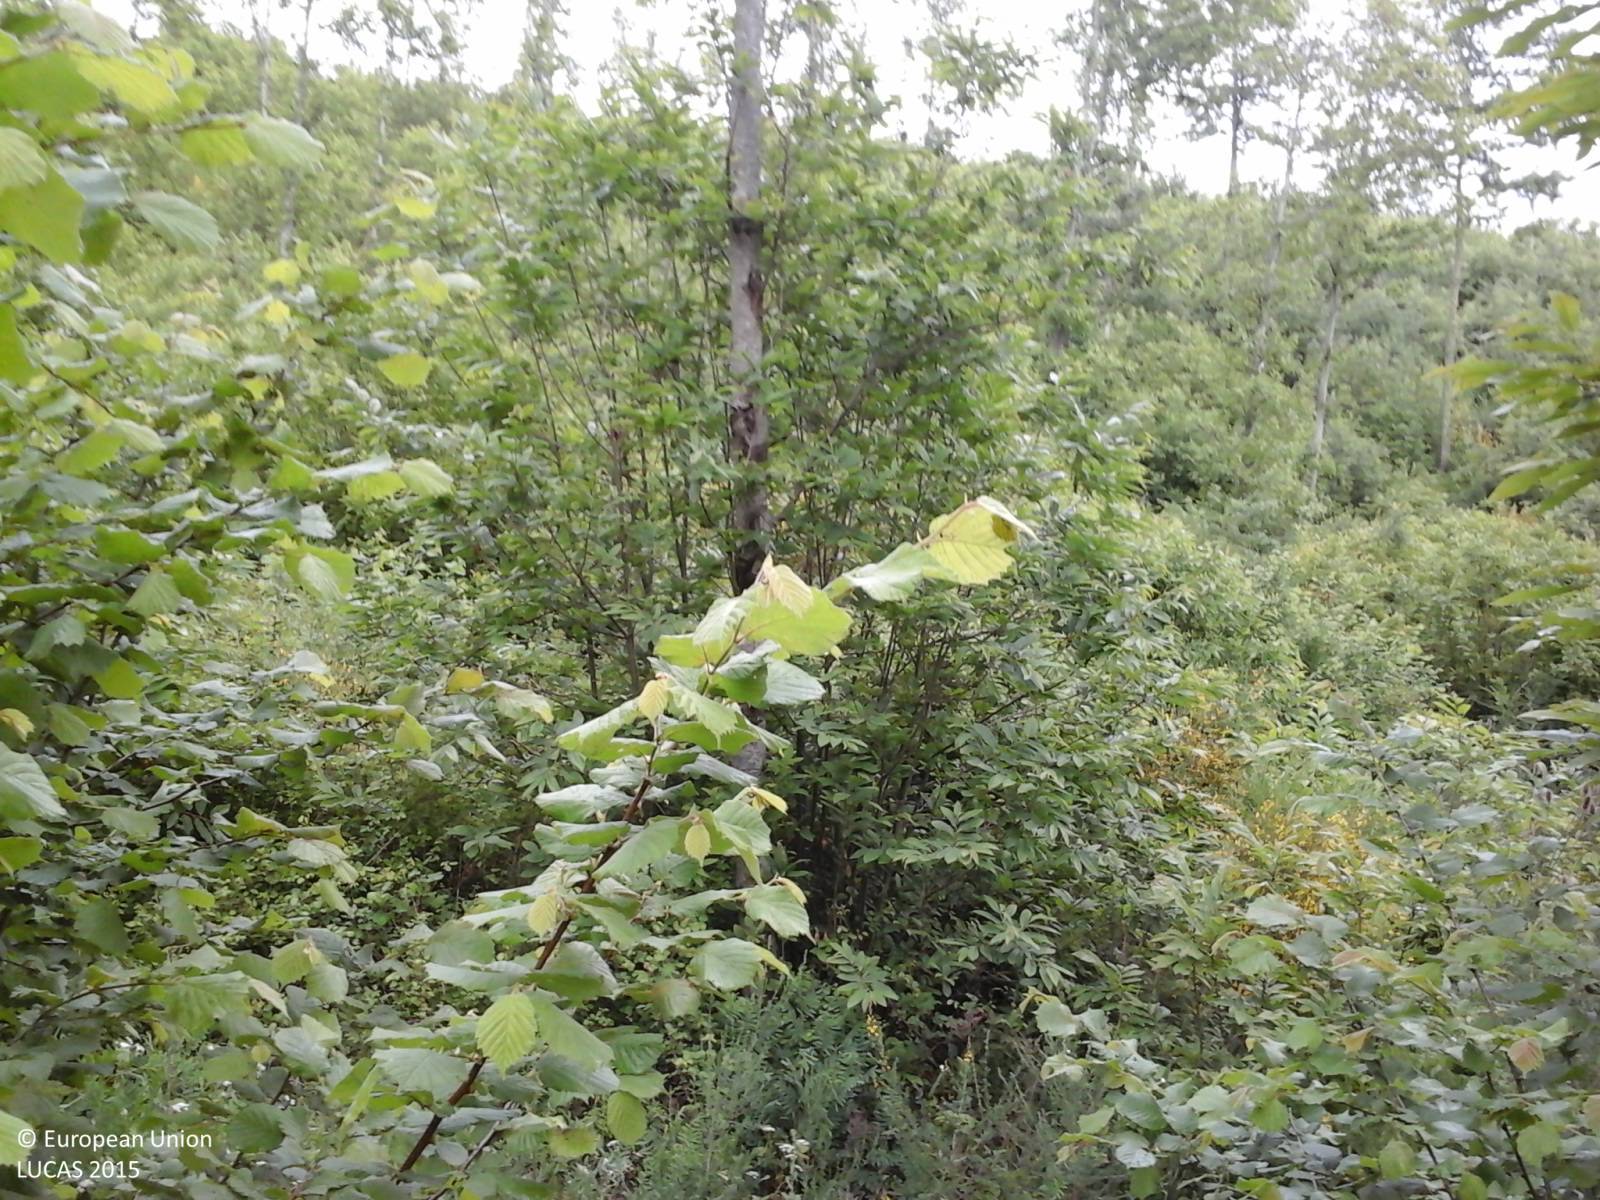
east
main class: Woodland
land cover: Broadleaved woodland
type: thermophilous deciduous forest
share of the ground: > 75 %
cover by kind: broadleaved forest trees 100 %
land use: Forestry
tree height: > 5 m
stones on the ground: < 10 %
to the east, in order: Broadleaved woodland
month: May
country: IT
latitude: 42.3402
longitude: 12.2377
